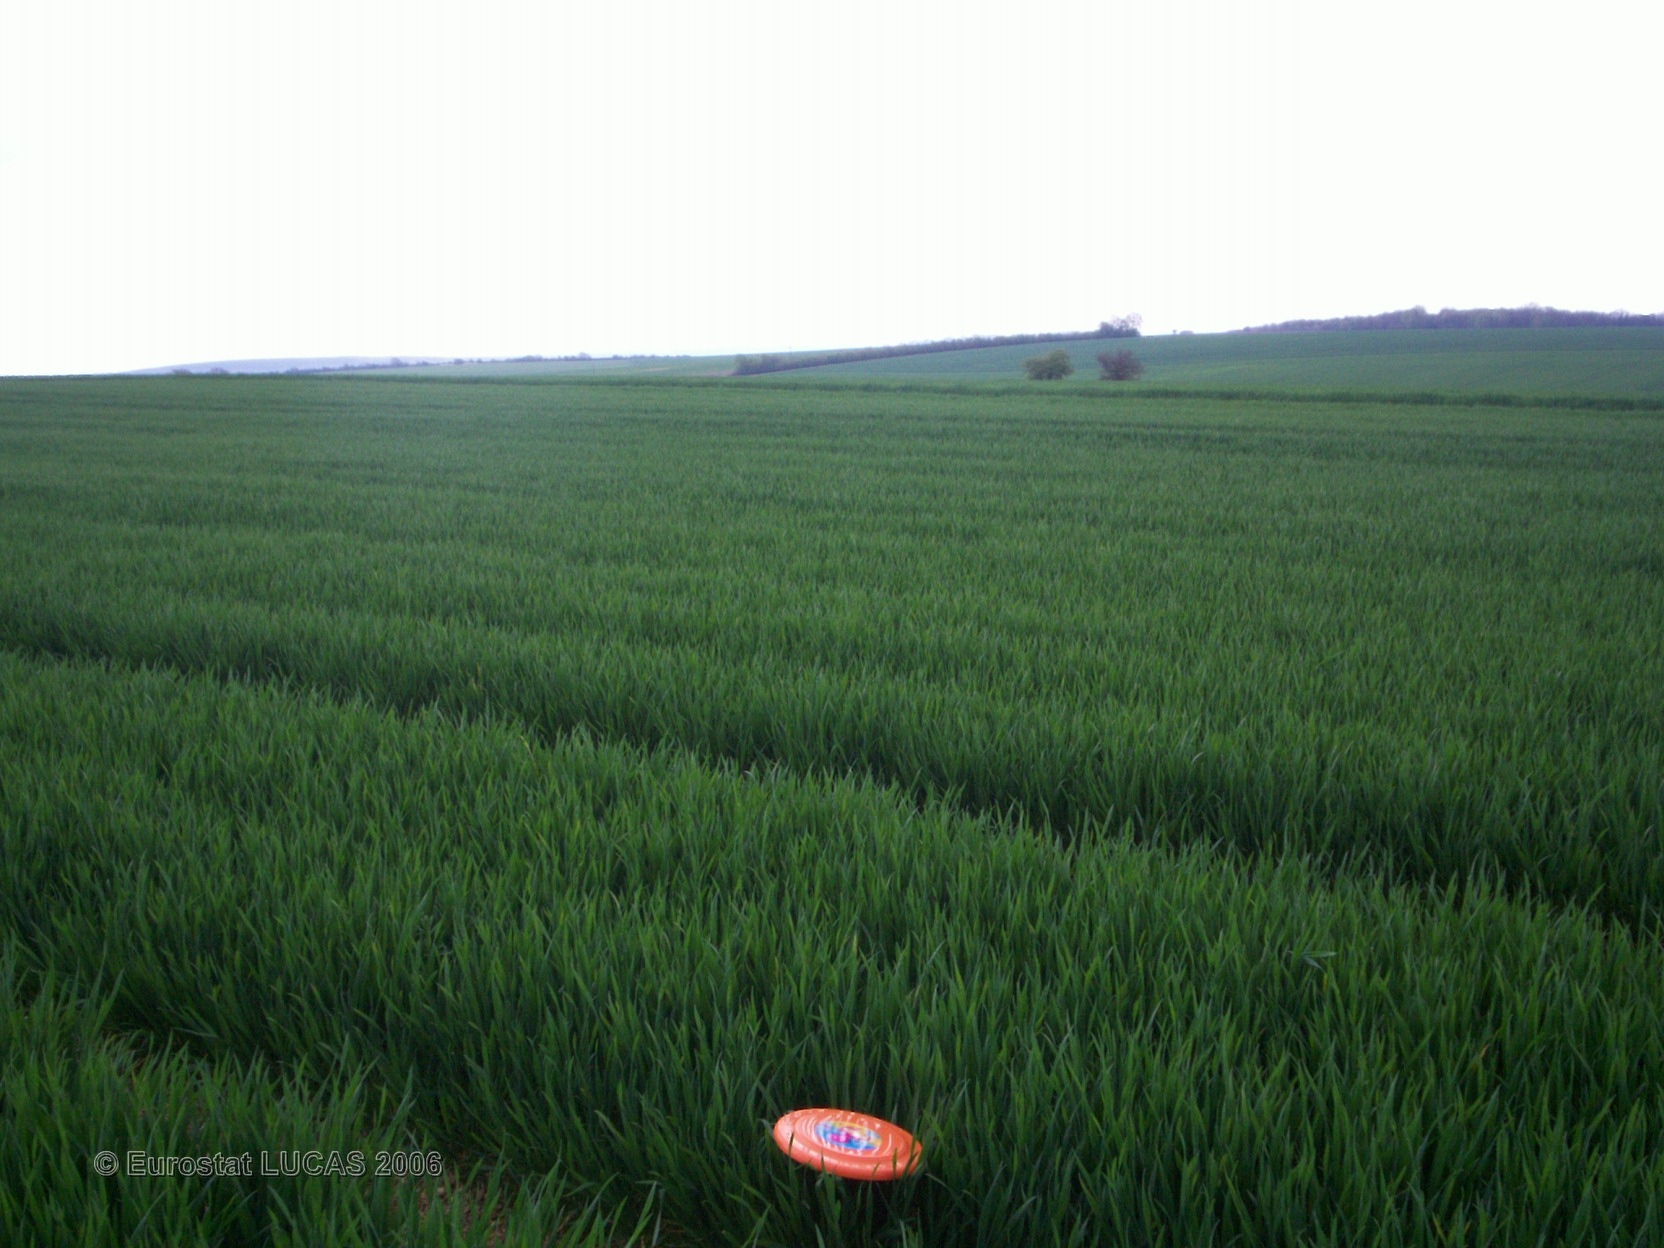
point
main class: Cropland
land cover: Common wheat
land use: Agriculture (excluding fallow land and kitchen gardens)
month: April
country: FR
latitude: 47.3535
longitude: 3.0446
